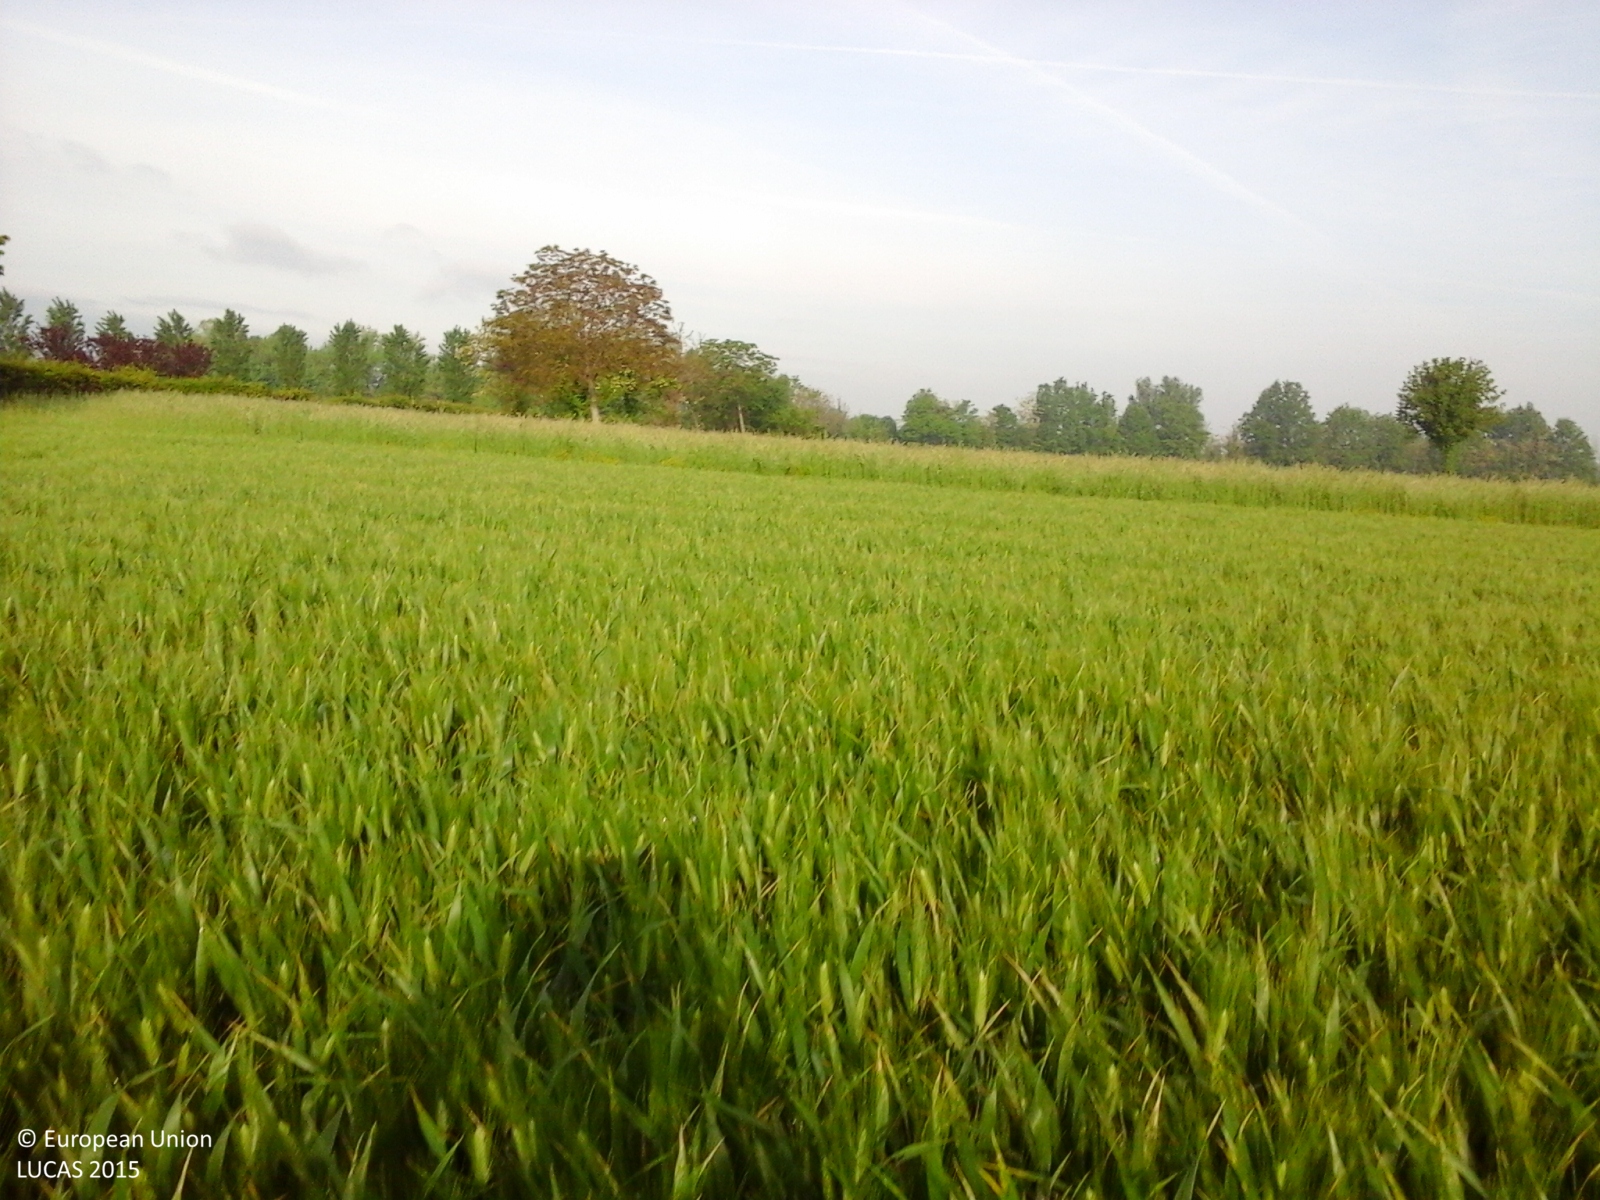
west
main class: Cropland
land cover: Common wheat
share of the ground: > 75 %
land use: Agriculture (excluding fallow land and kitchen gardens)
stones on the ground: < 10 %
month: May
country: IT
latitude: 44.9629
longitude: 9.6078
